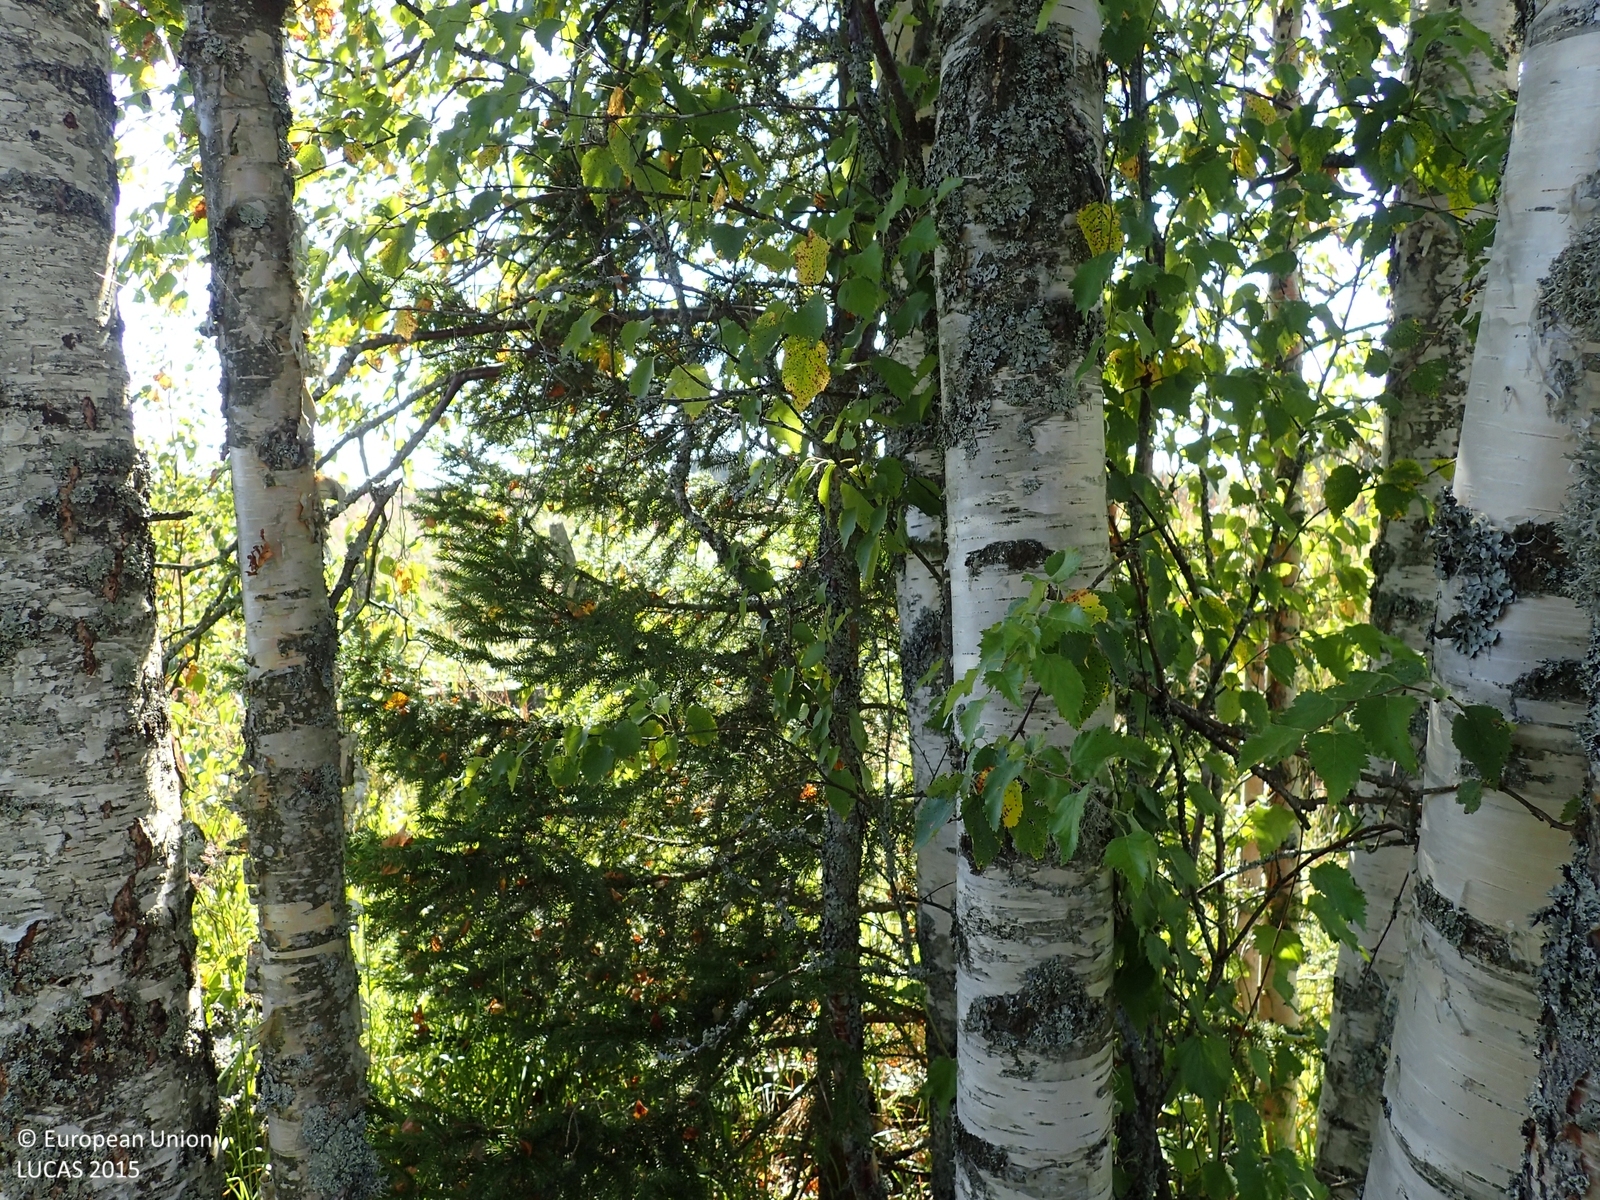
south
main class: Woodland
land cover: Broadleaved woodland
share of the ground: 25 - 50 %
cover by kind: herbaceous plants 60 %, broadleaved forest trees 40 %
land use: Residential
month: August
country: FI
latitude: 62.3261
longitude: 21.8410
